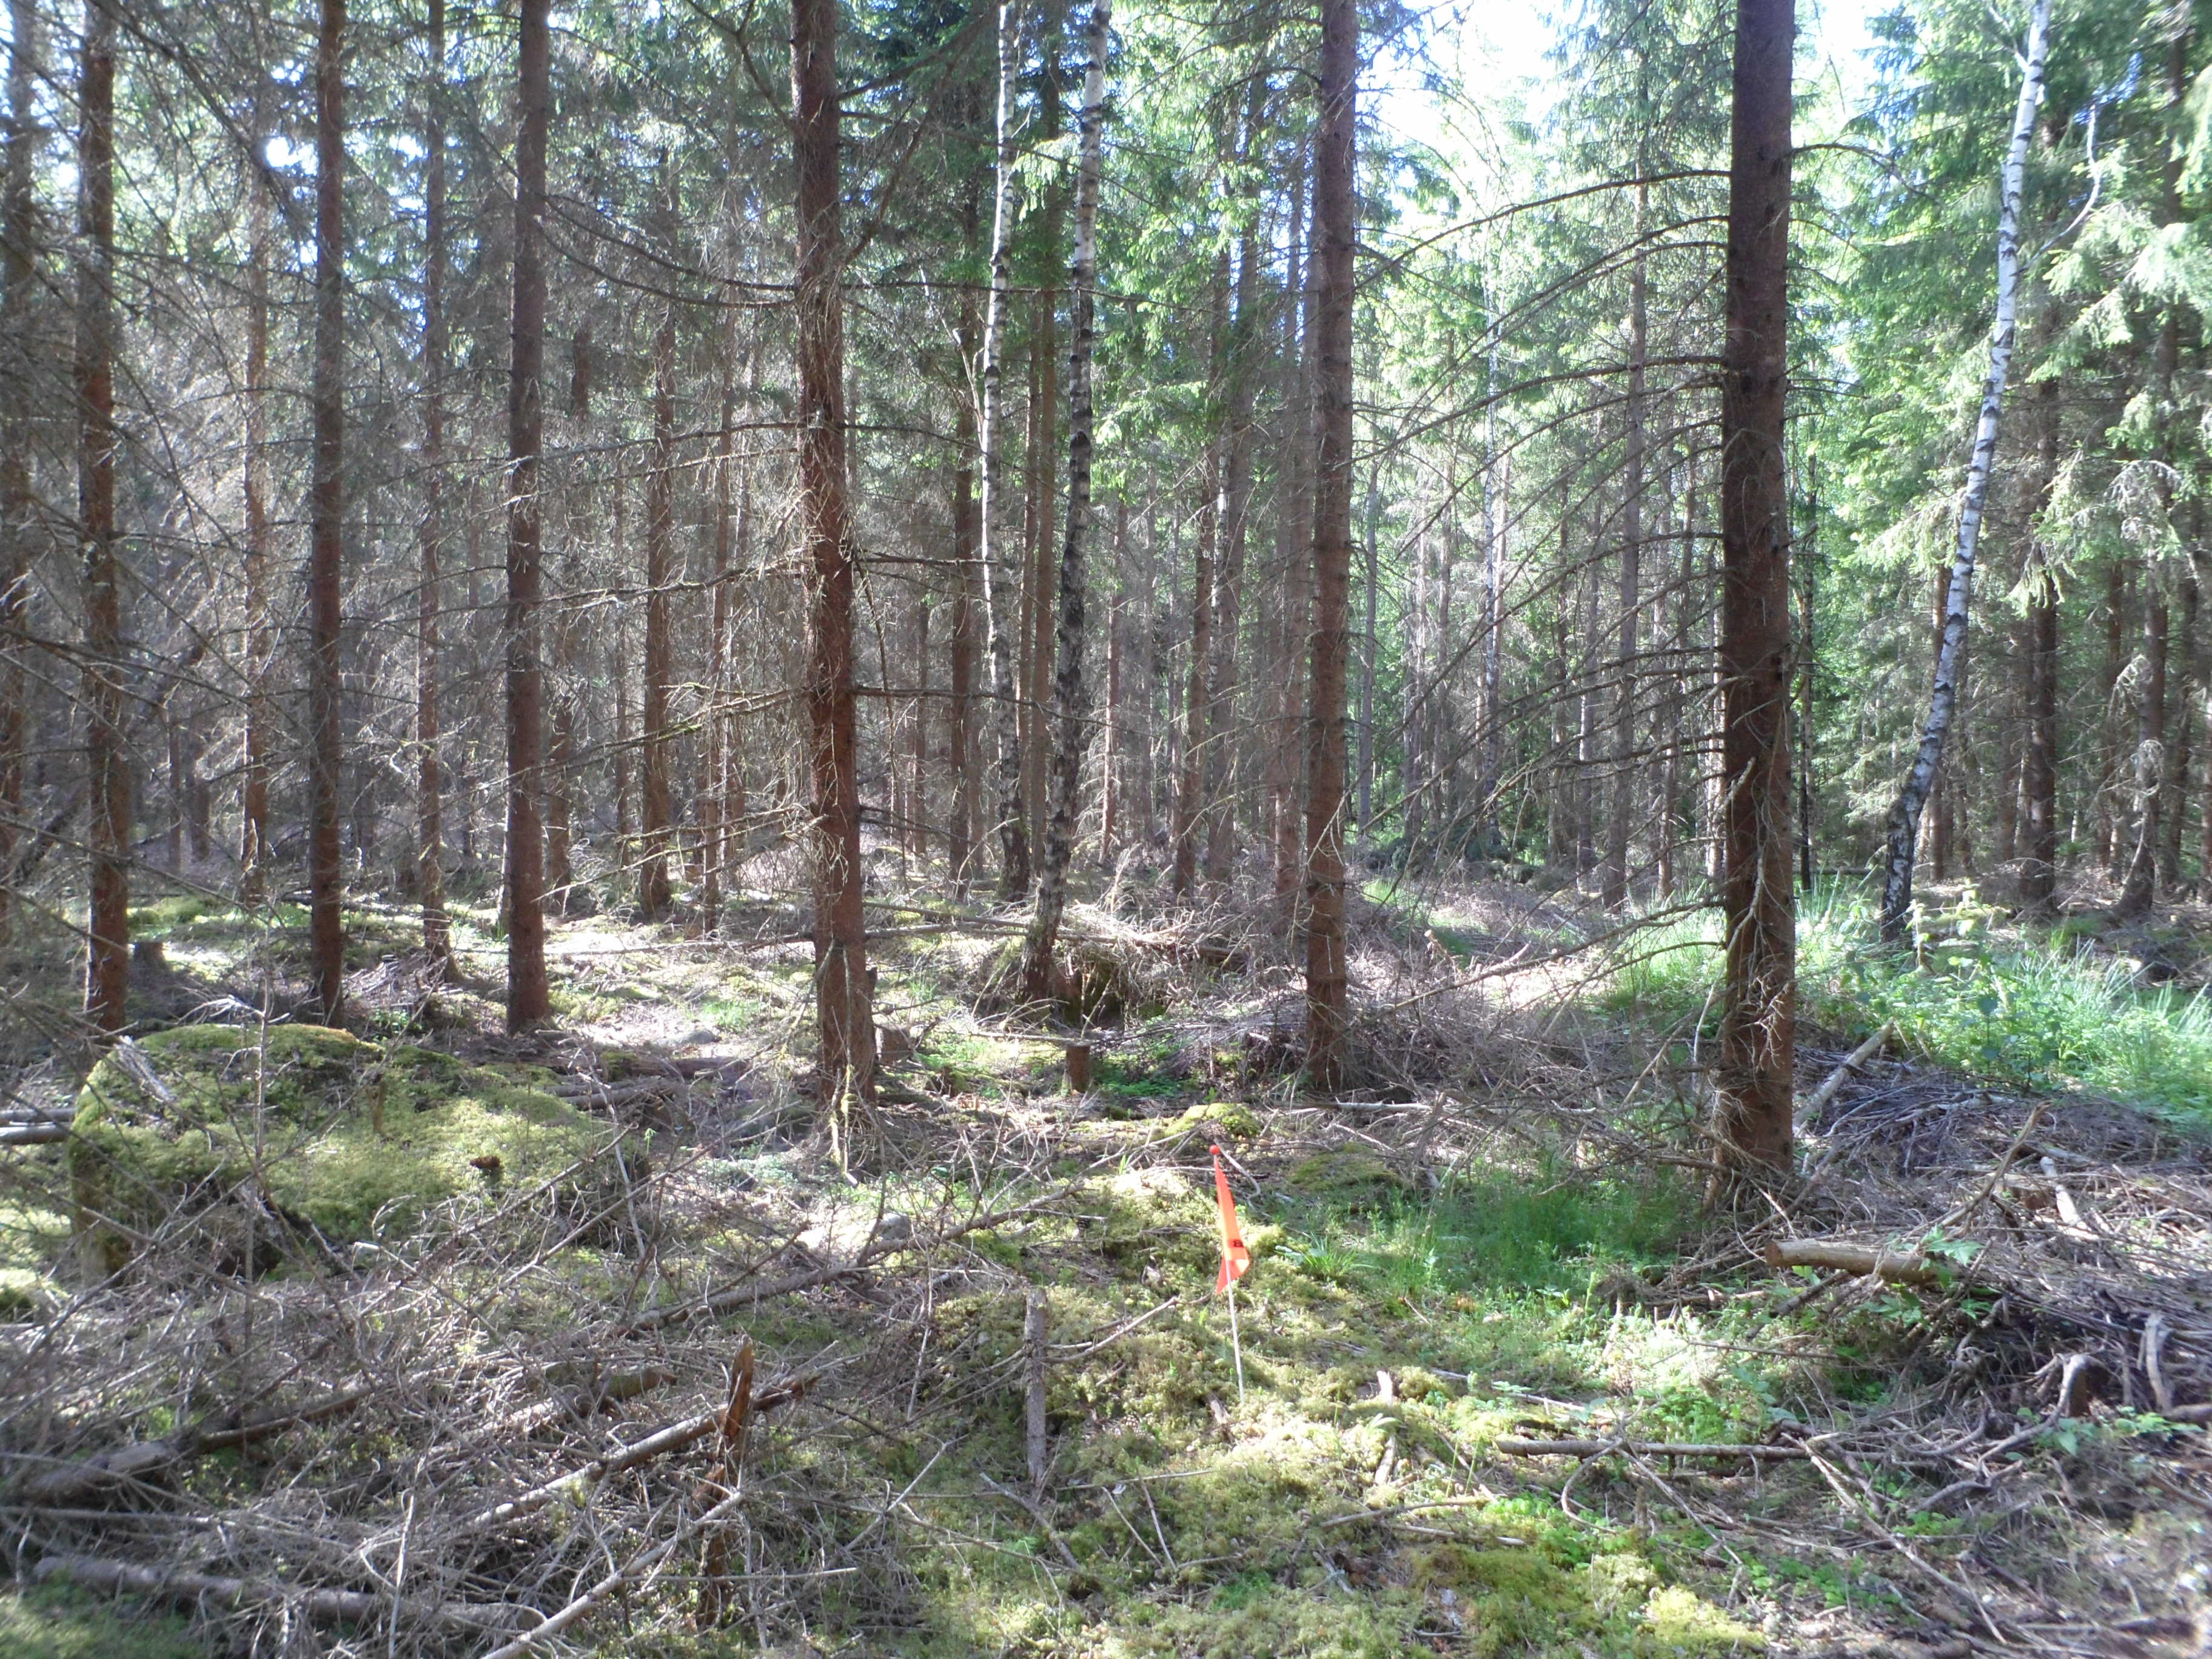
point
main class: Woodland
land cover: Spruce dominated coniferous woodland
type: boreal forest
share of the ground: 50 - 75 %
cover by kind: coniferous forest trees 65 %, lichens and mosses 25 %, broadleaved forest trees 5 %, herbaceous plants 5 %
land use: Forestry
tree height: > 5 m
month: June
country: SE
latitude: 56.9609
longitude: 14.8484
